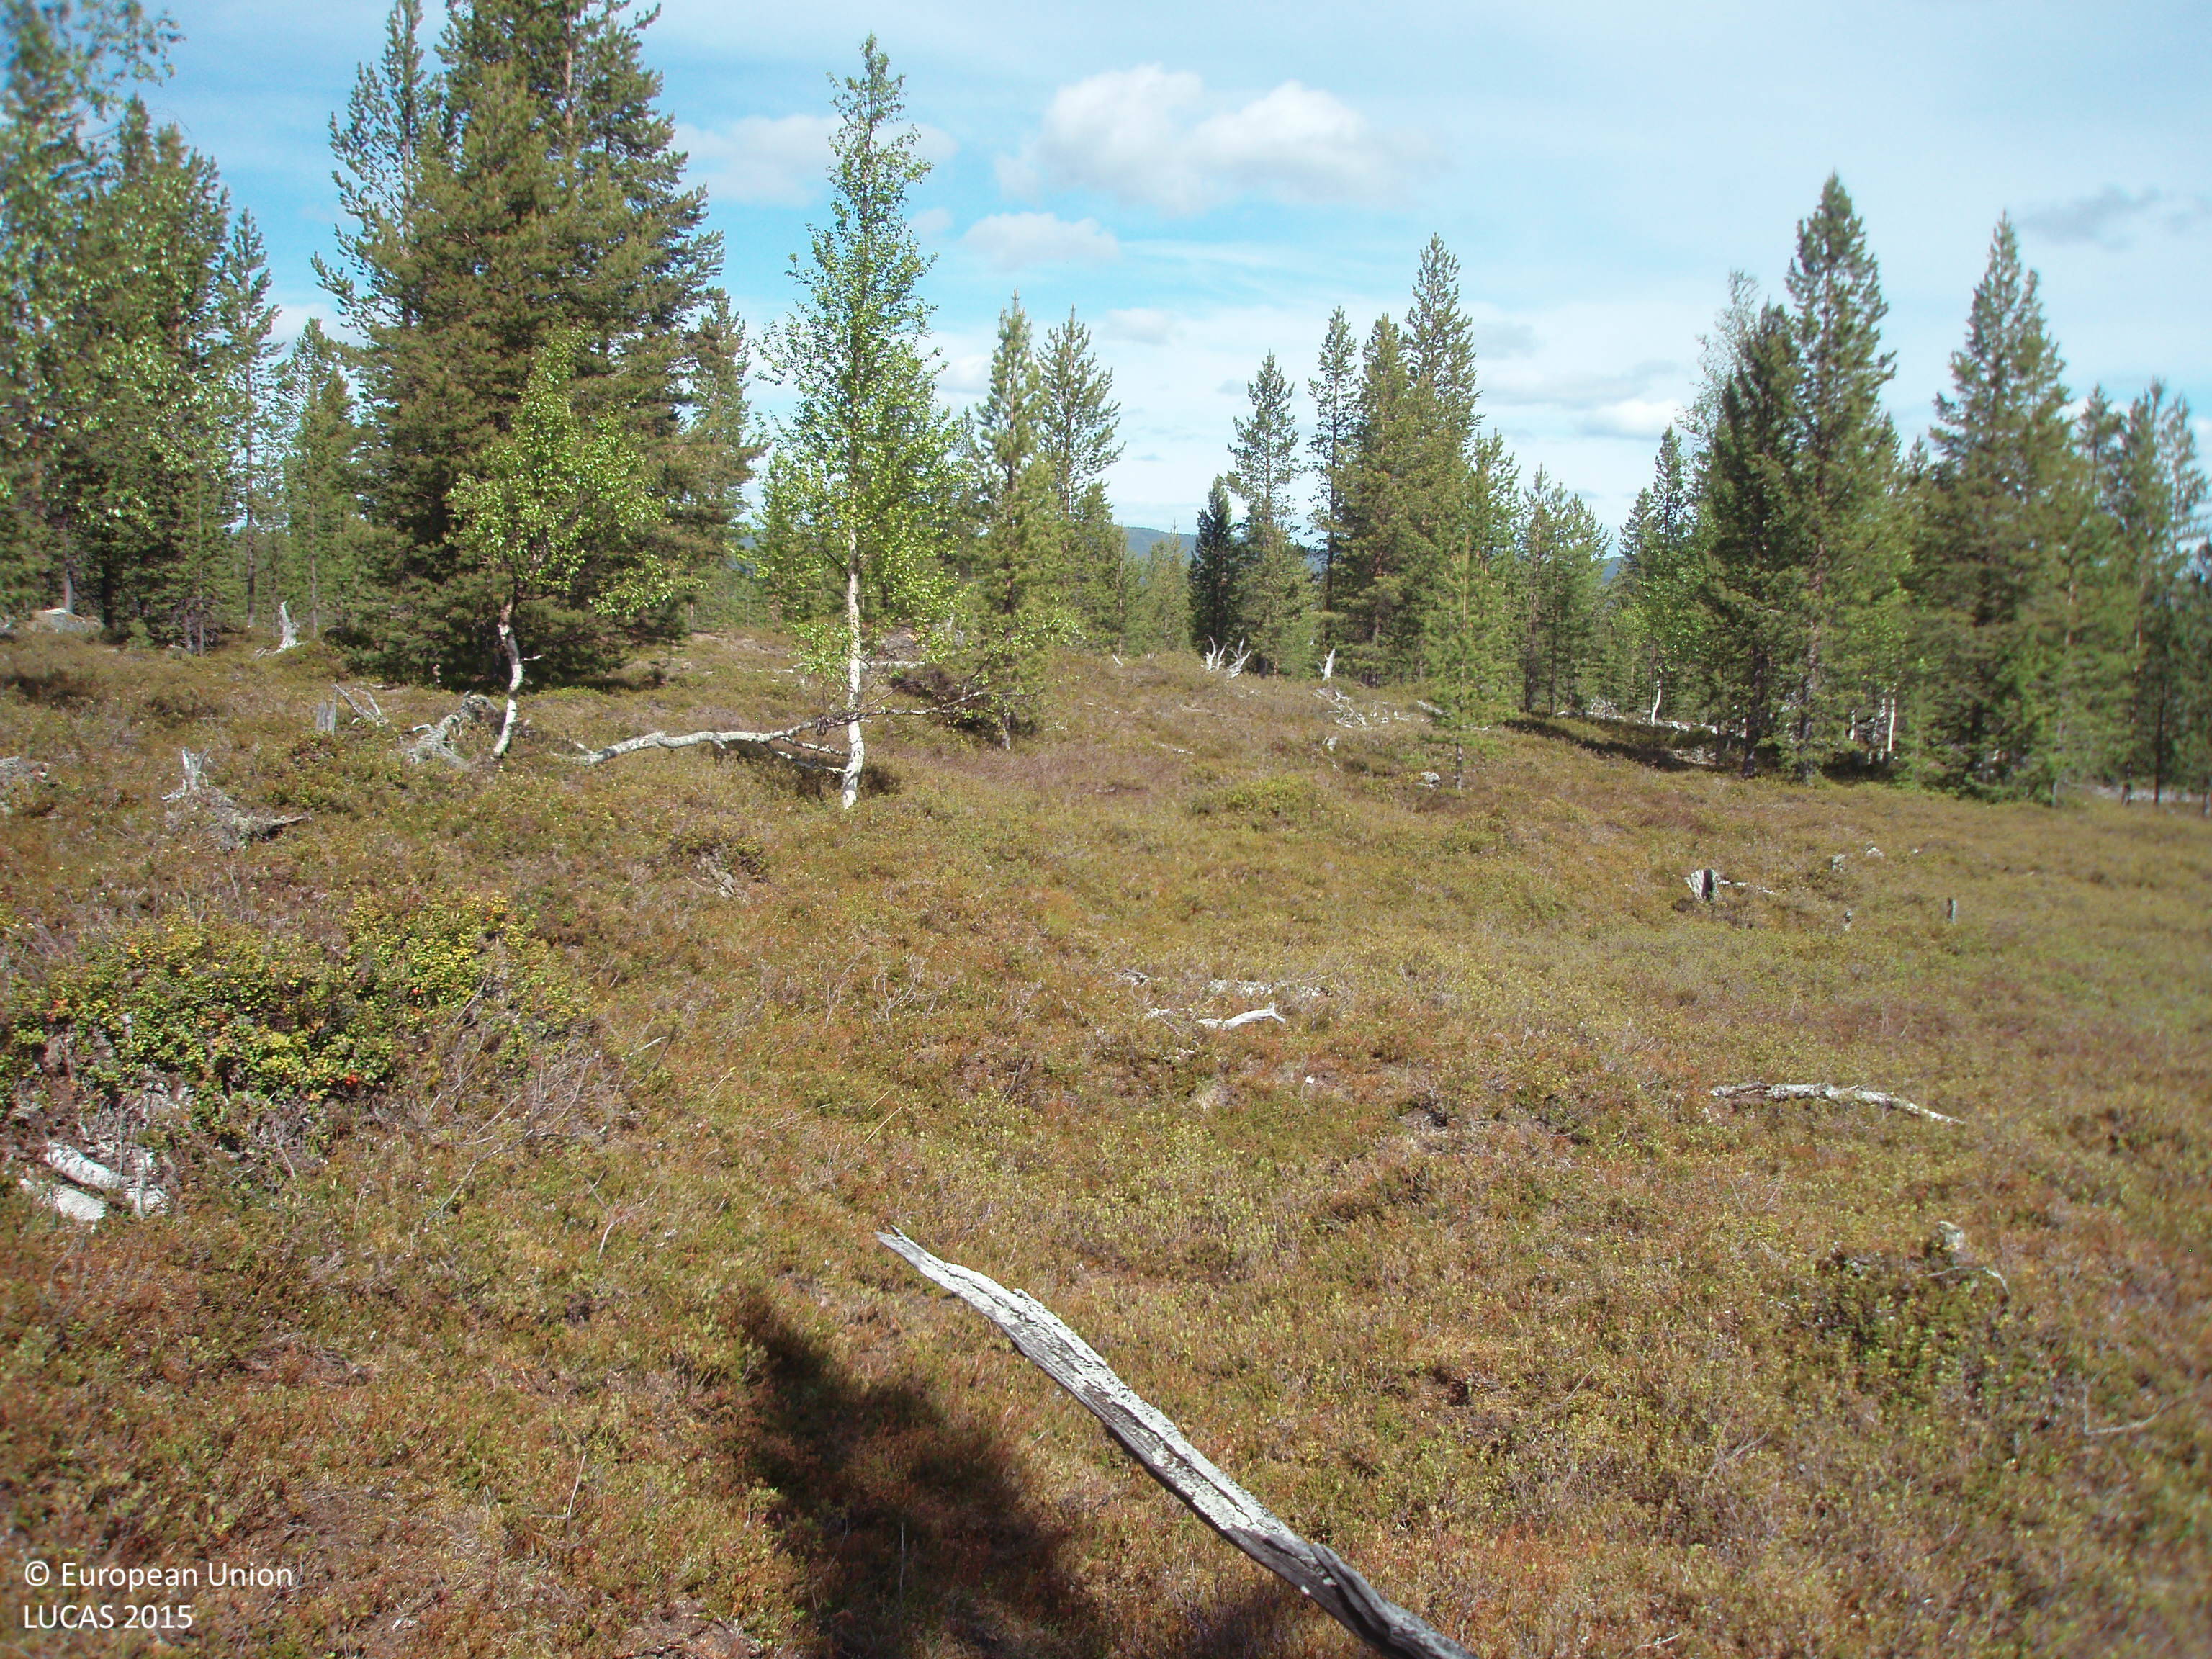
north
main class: Woodland
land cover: Pine dominated coniferous woodland
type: boreal forest
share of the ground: 25 - 50 %
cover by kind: shrubs 50 %, coniferous forest trees 35 %, lichens and mosses 10 %, broadleaved forest trees 5 %
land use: Forestry
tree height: > 5 m
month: June
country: FI
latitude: 68.6269
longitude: 28.0168
